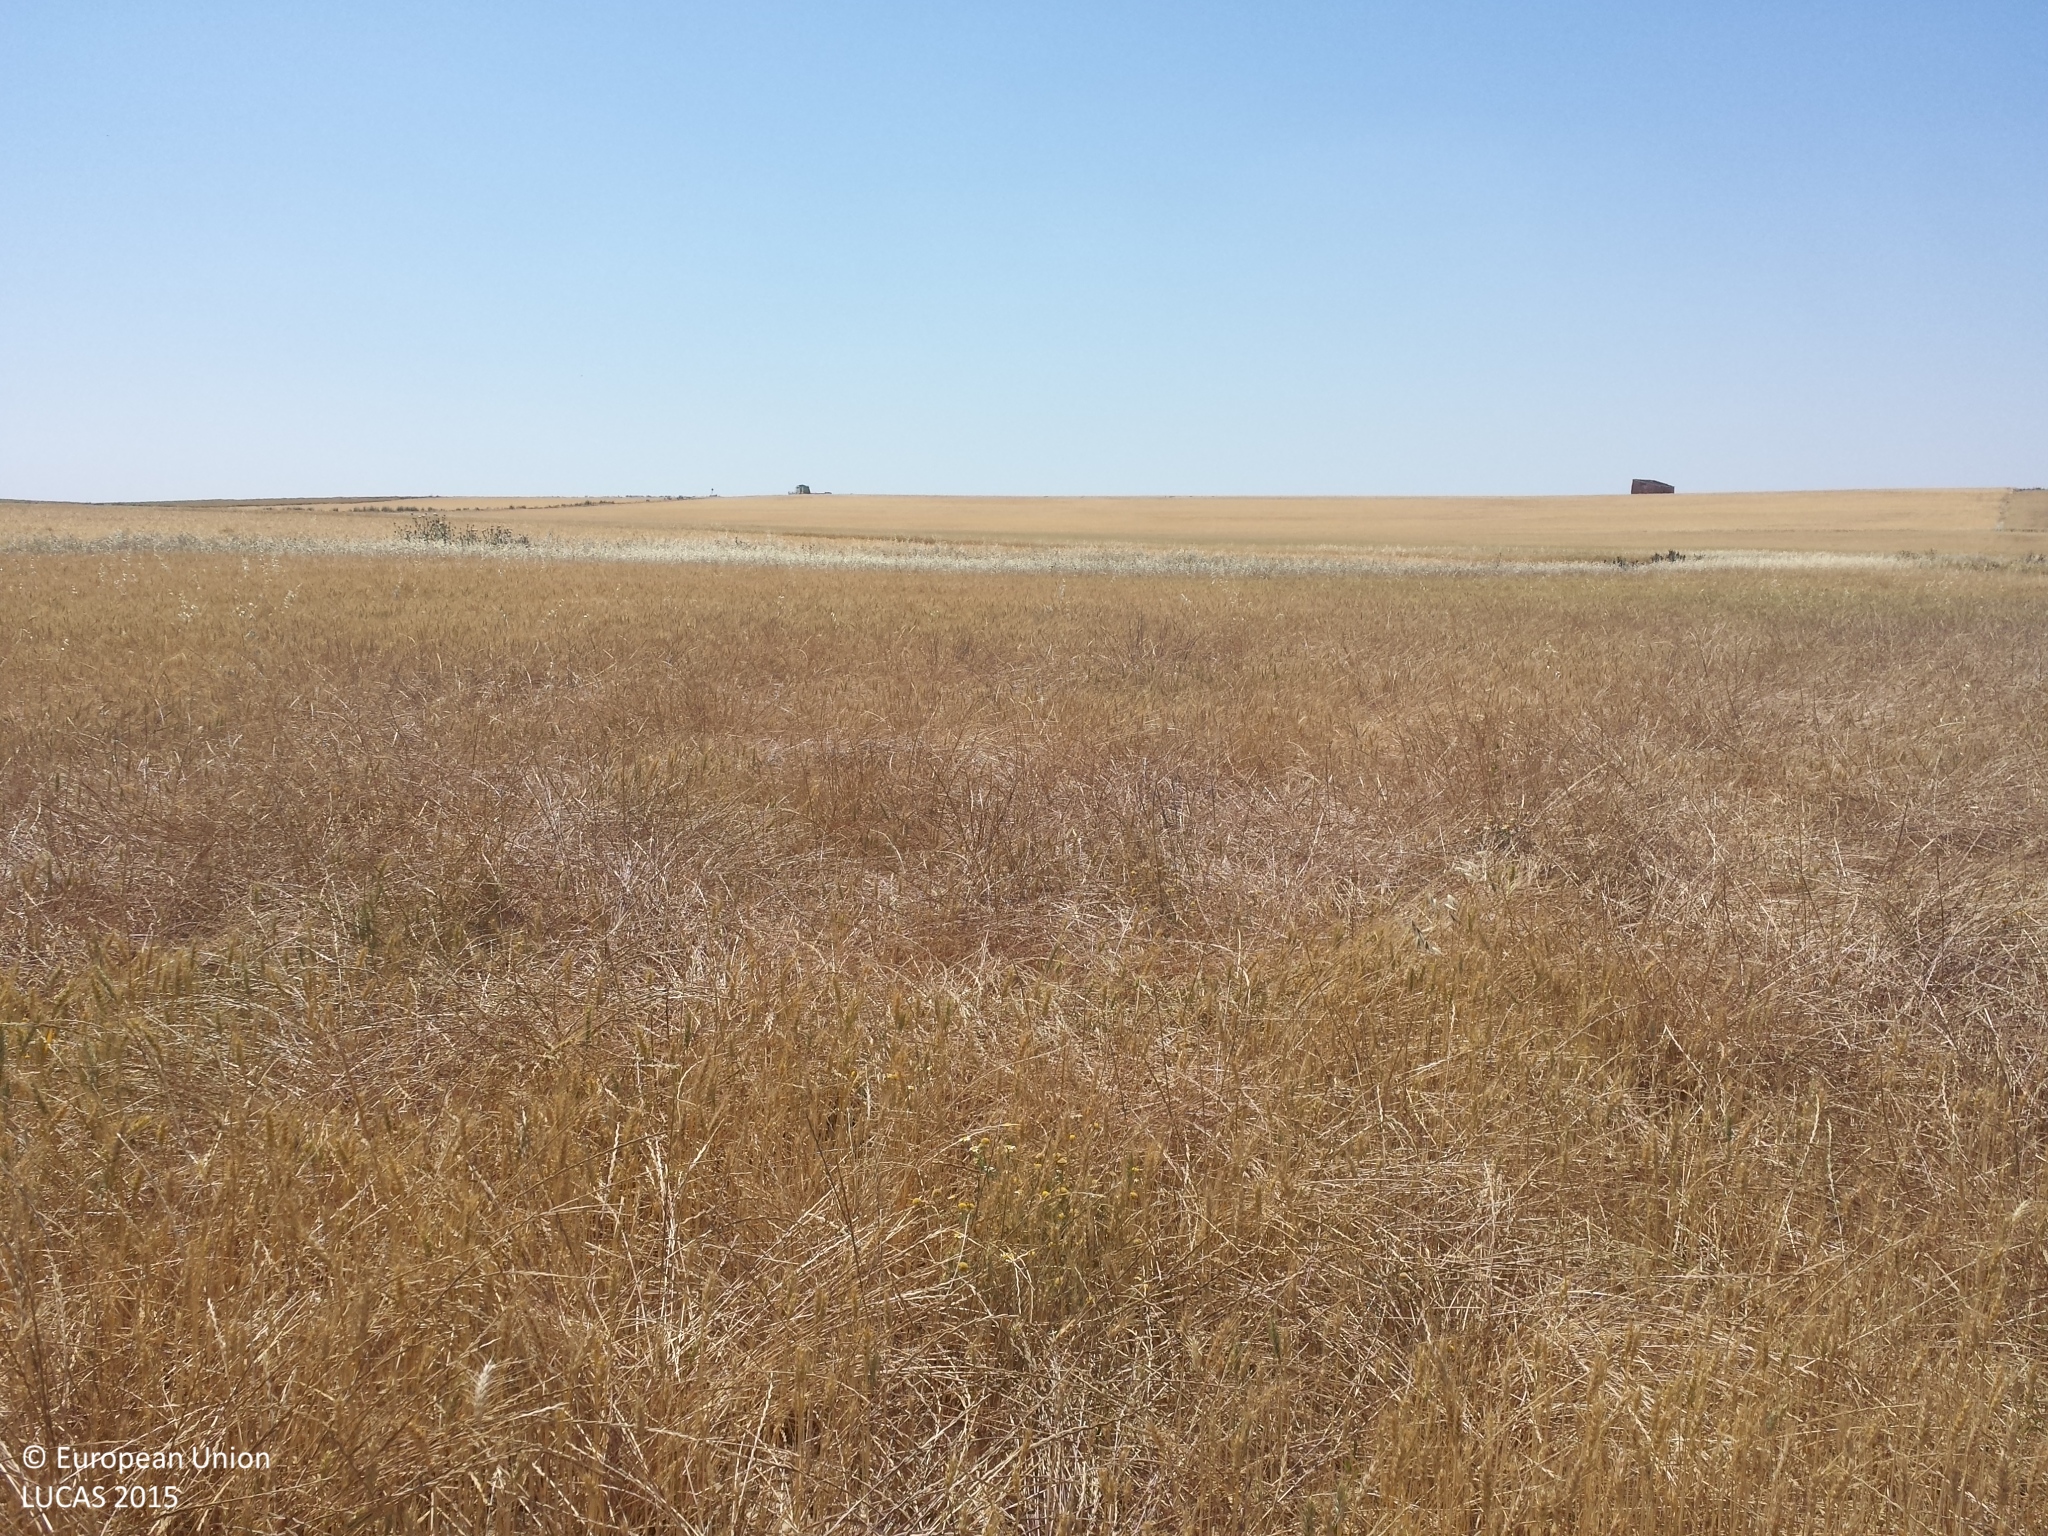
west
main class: Cropland
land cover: Common wheat
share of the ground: > 75 %
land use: Agriculture (excluding fallow land and kitchen gardens)
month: May
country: ES
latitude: 41.7564
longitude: 0.5450
